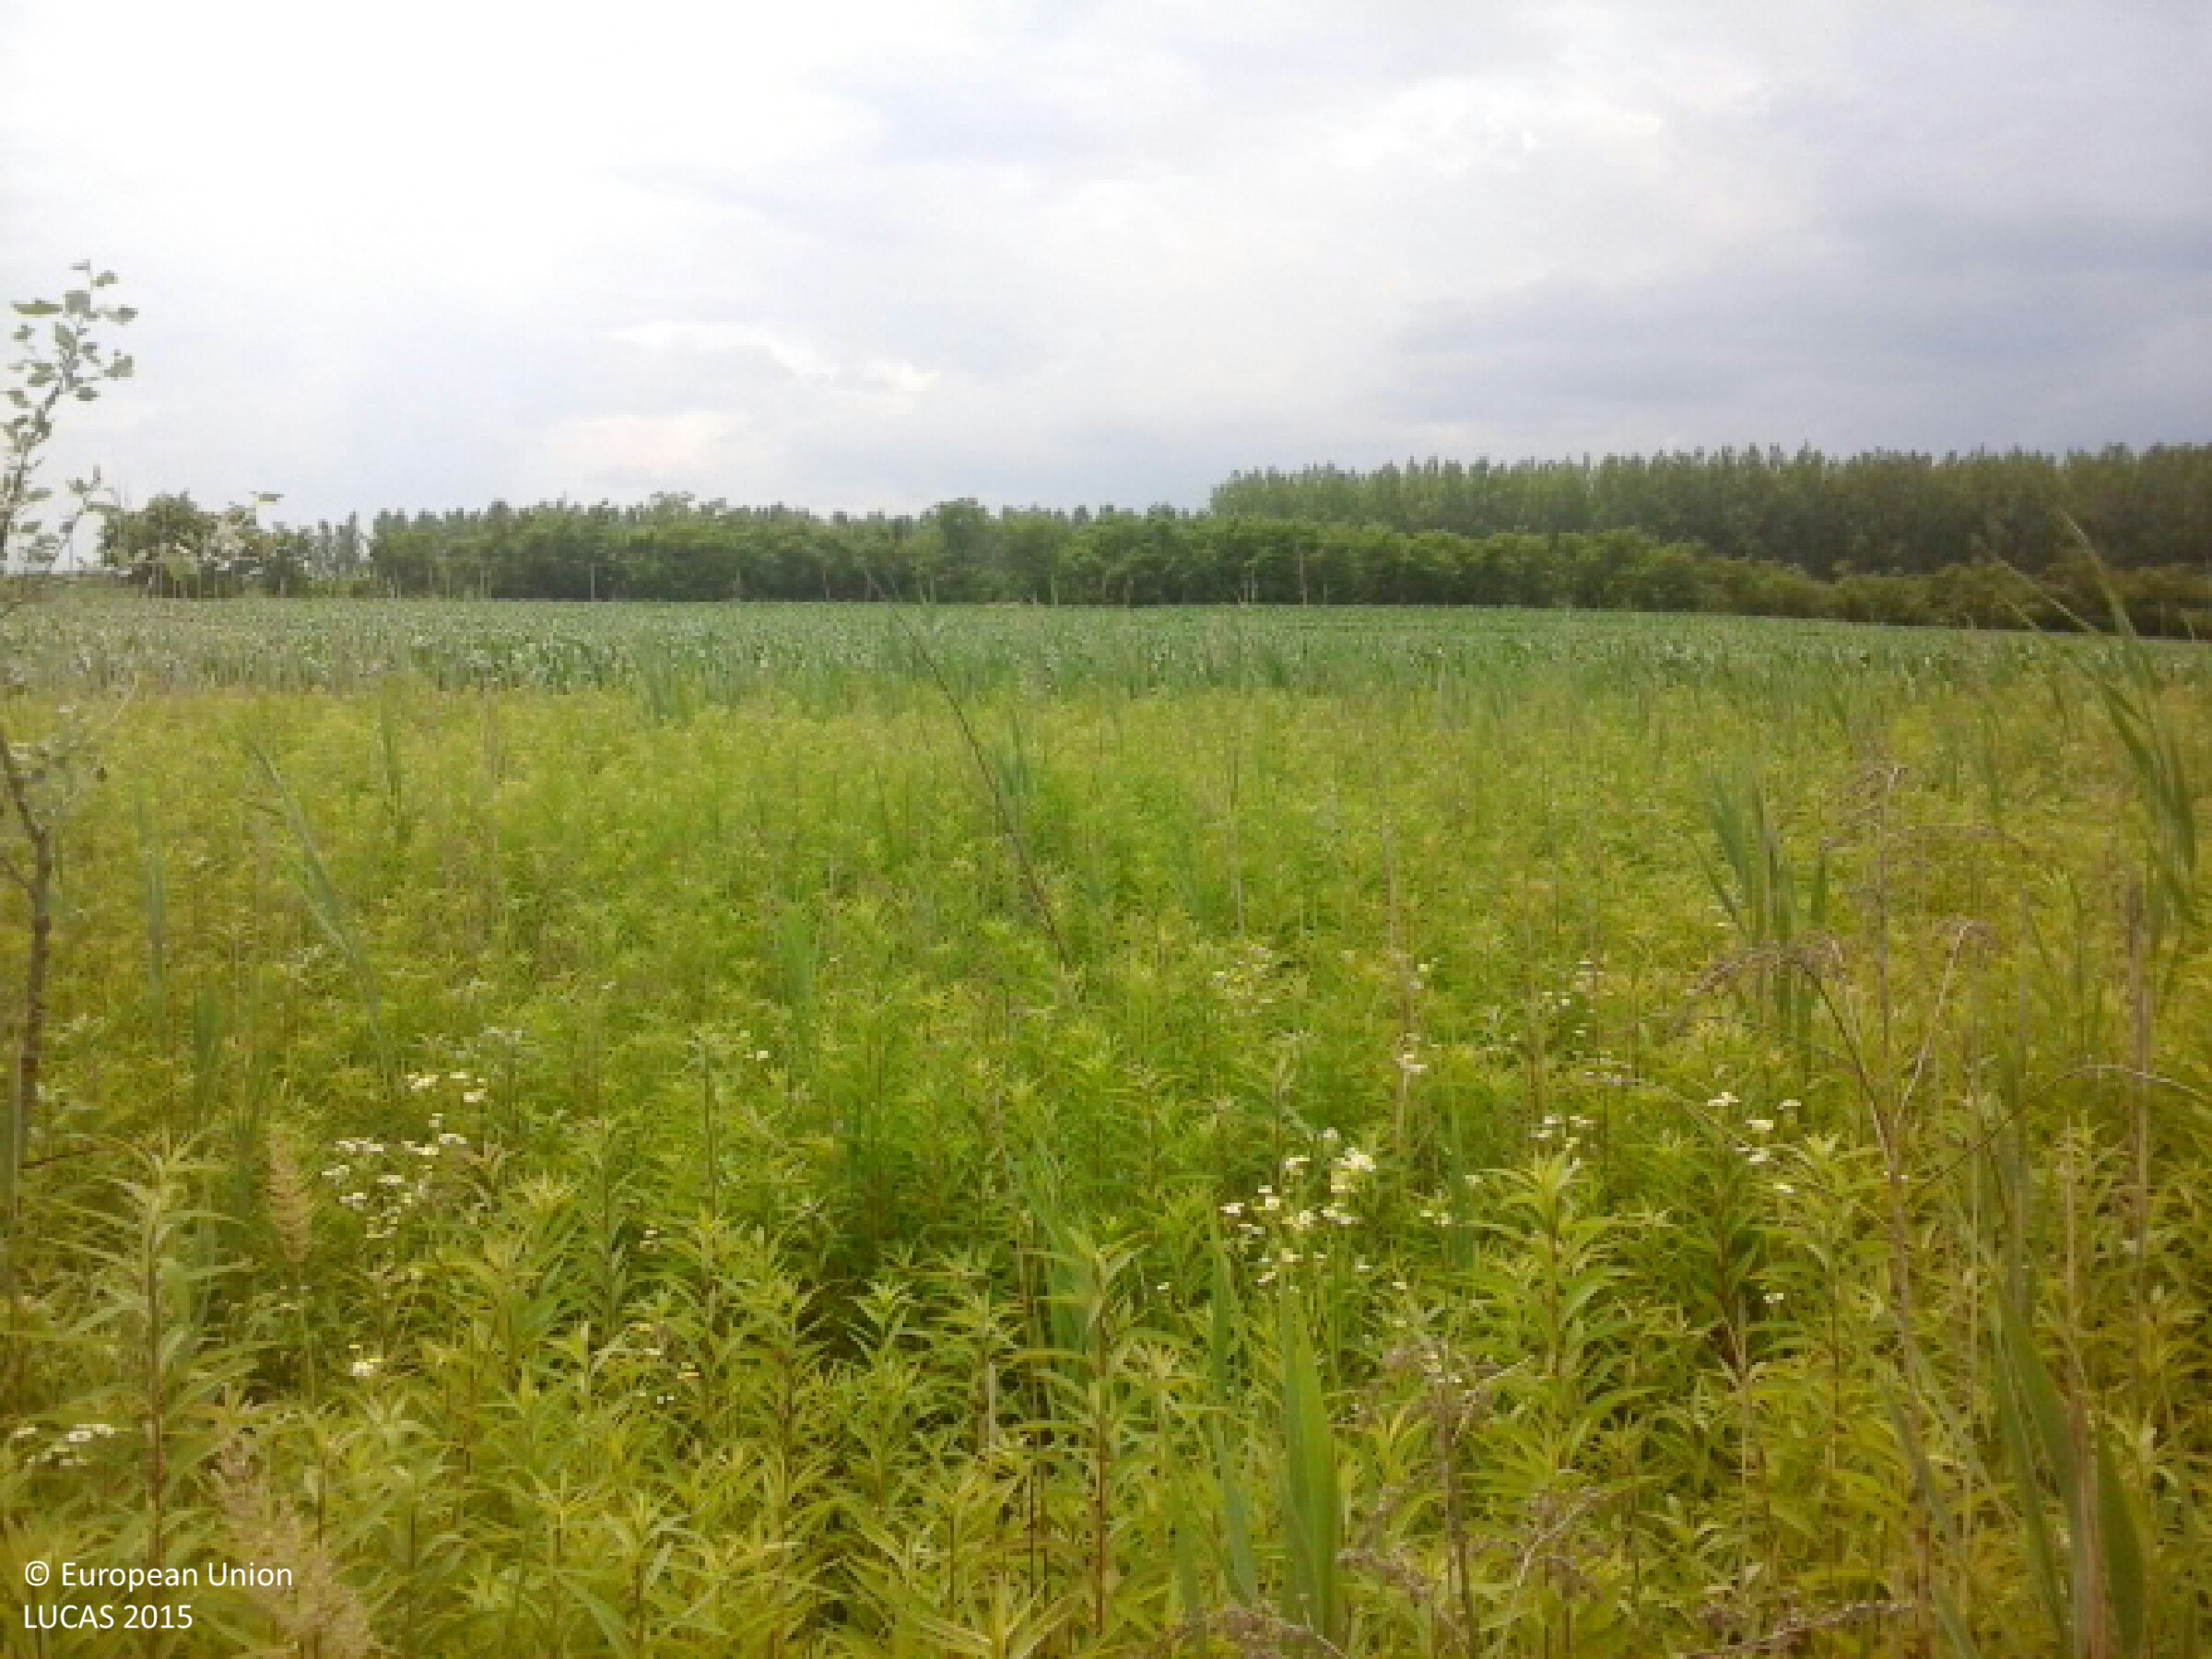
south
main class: Grassland
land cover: Spontaneously vegetated surfaces
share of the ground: > 75 %
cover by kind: herbaceous plants 95 %, shrubs 5 %
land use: Abandoned areas
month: June
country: HU
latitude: 48.1472
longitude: 22.0016
